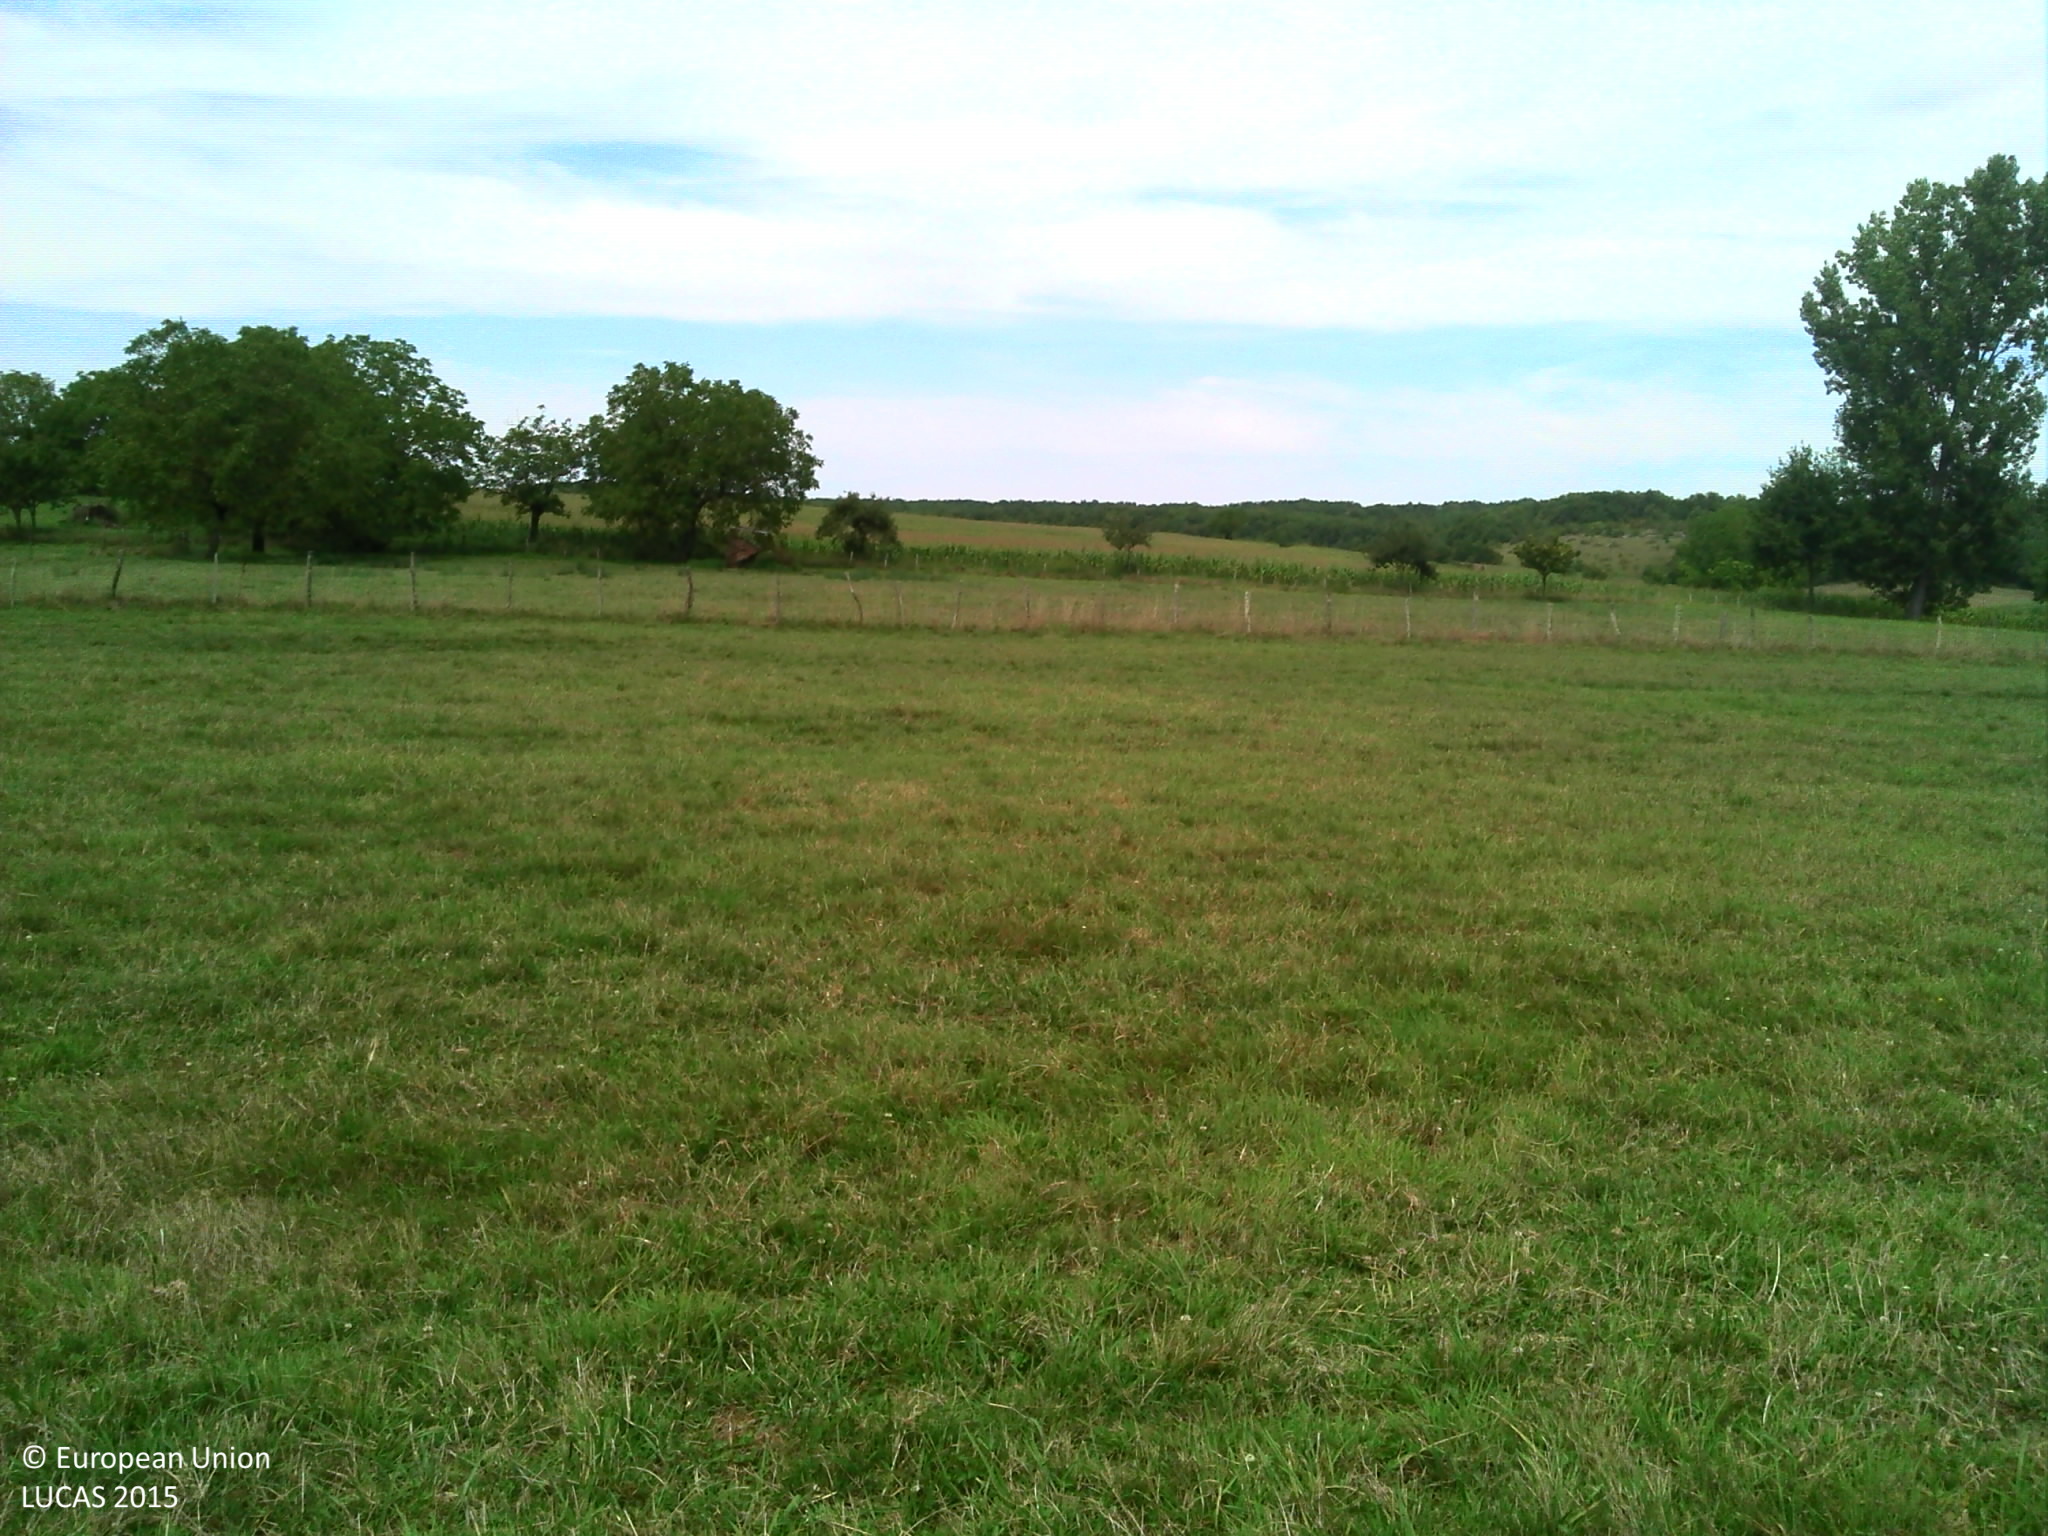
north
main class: Grassland
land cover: Grassland without tree/shrub cover
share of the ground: > 75 %
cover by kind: herbaceous plants 90 %, lichens and mosses 10 %
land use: Agriculture (excluding fallow land and kitchen gardens)
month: August
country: FR
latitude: 45.3476
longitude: 0.5047
